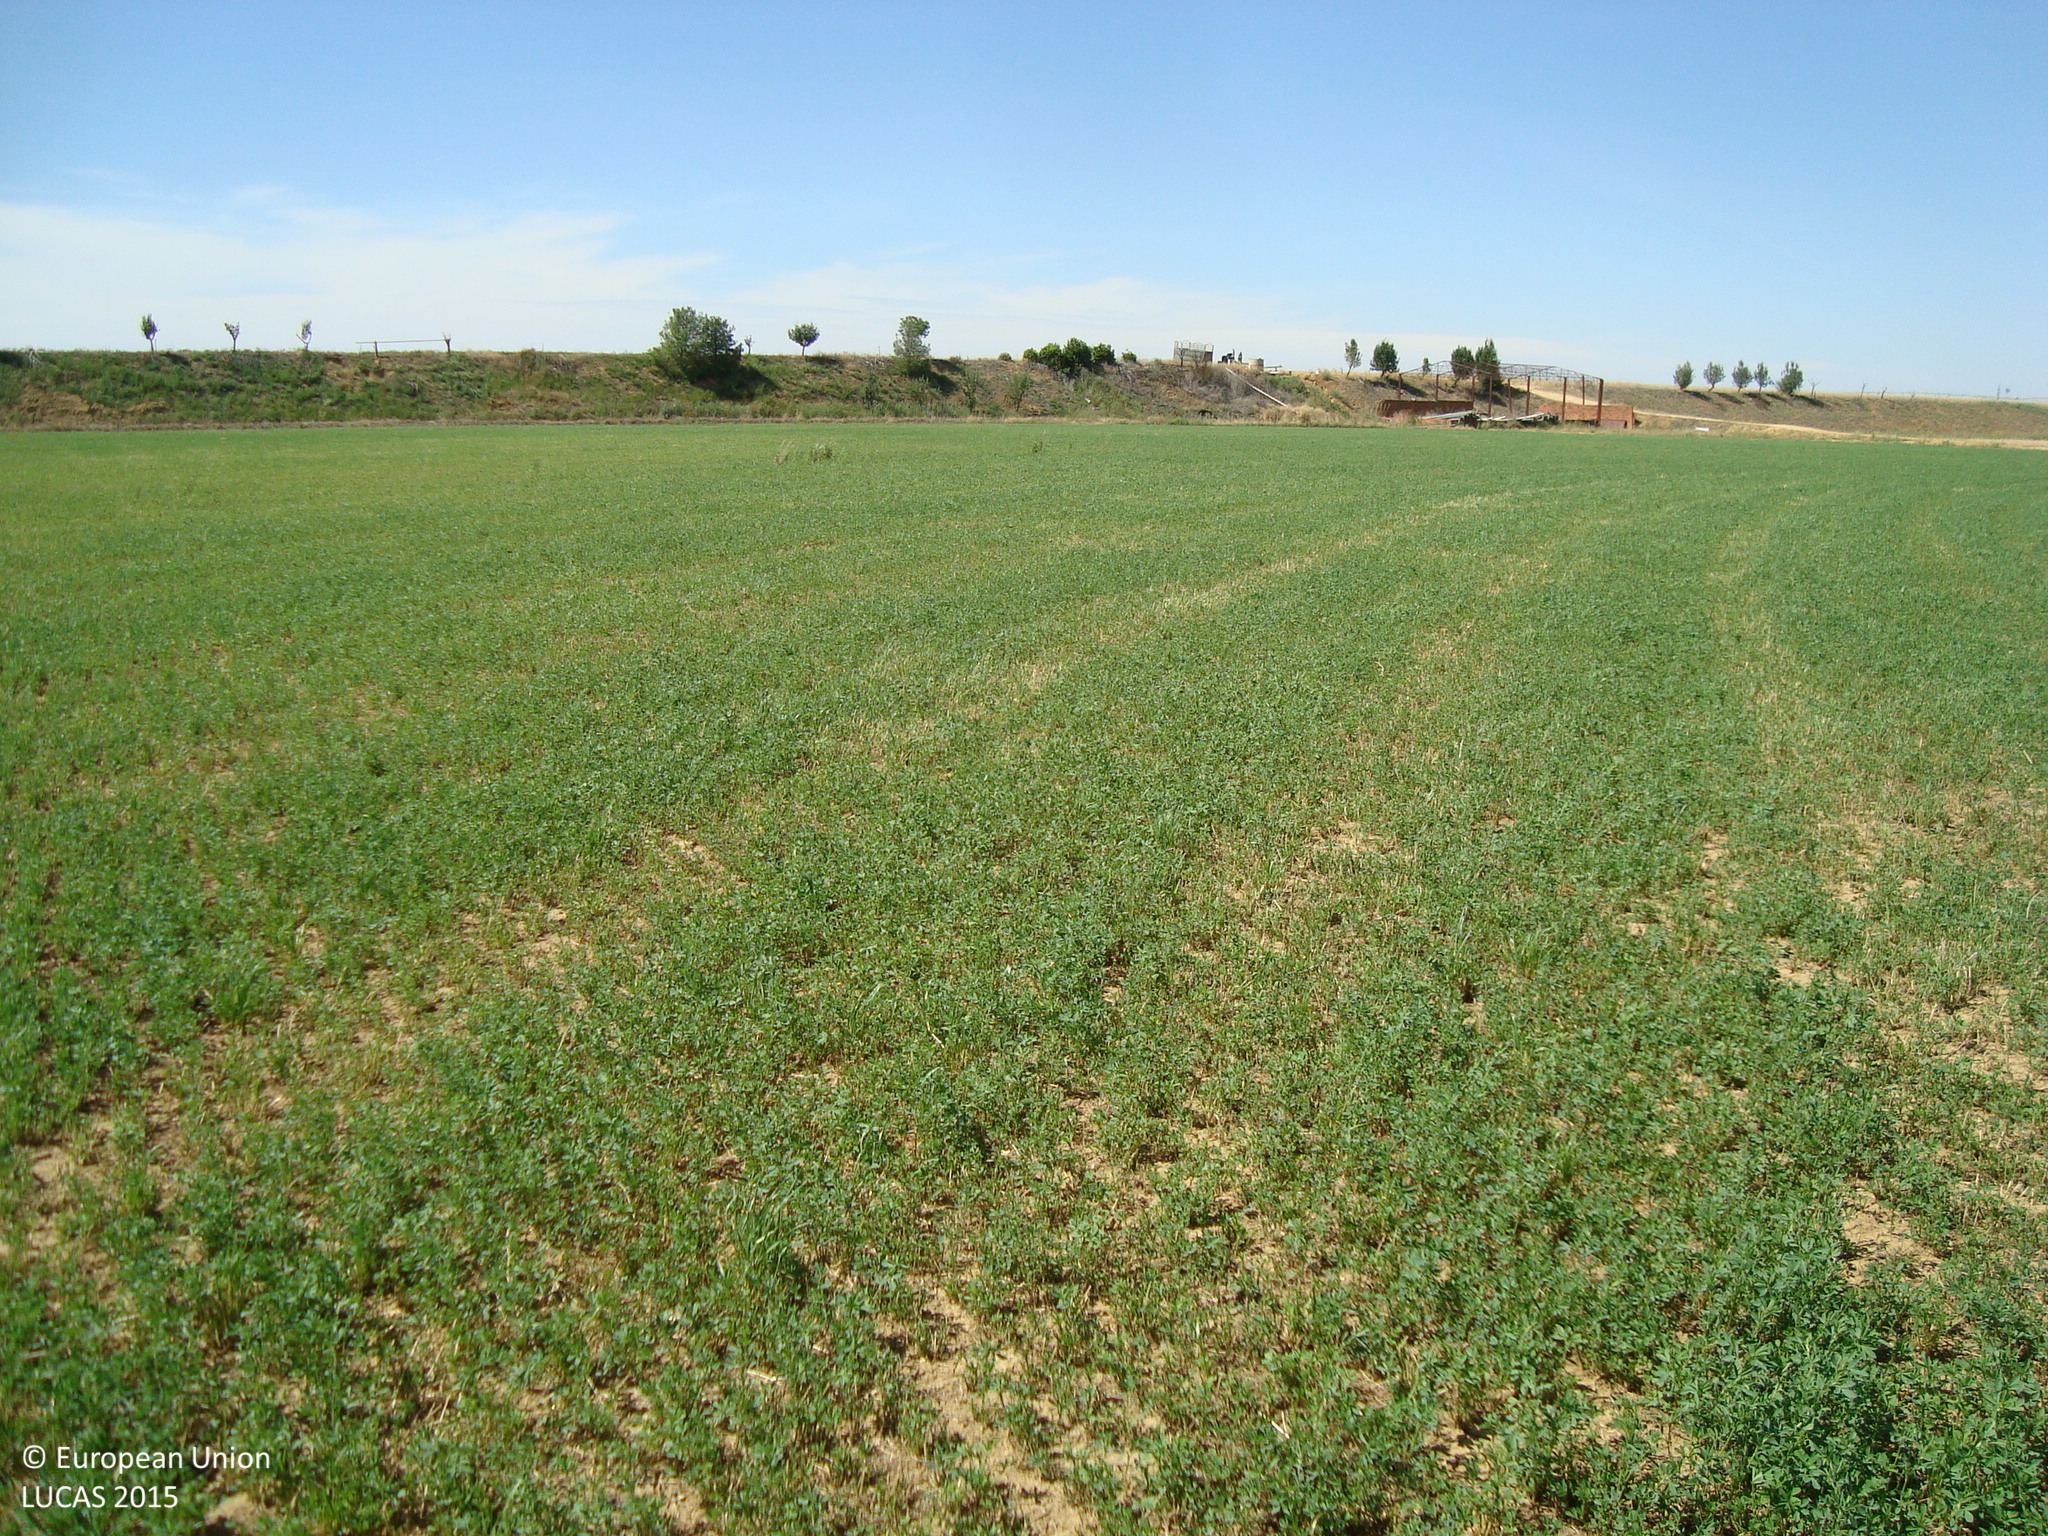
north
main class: Cropland
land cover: Lucerne
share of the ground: > 75 %
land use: Agriculture (excluding fallow land and kitchen gardens)
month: July
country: ES
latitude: 42.1354
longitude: -4.7510
